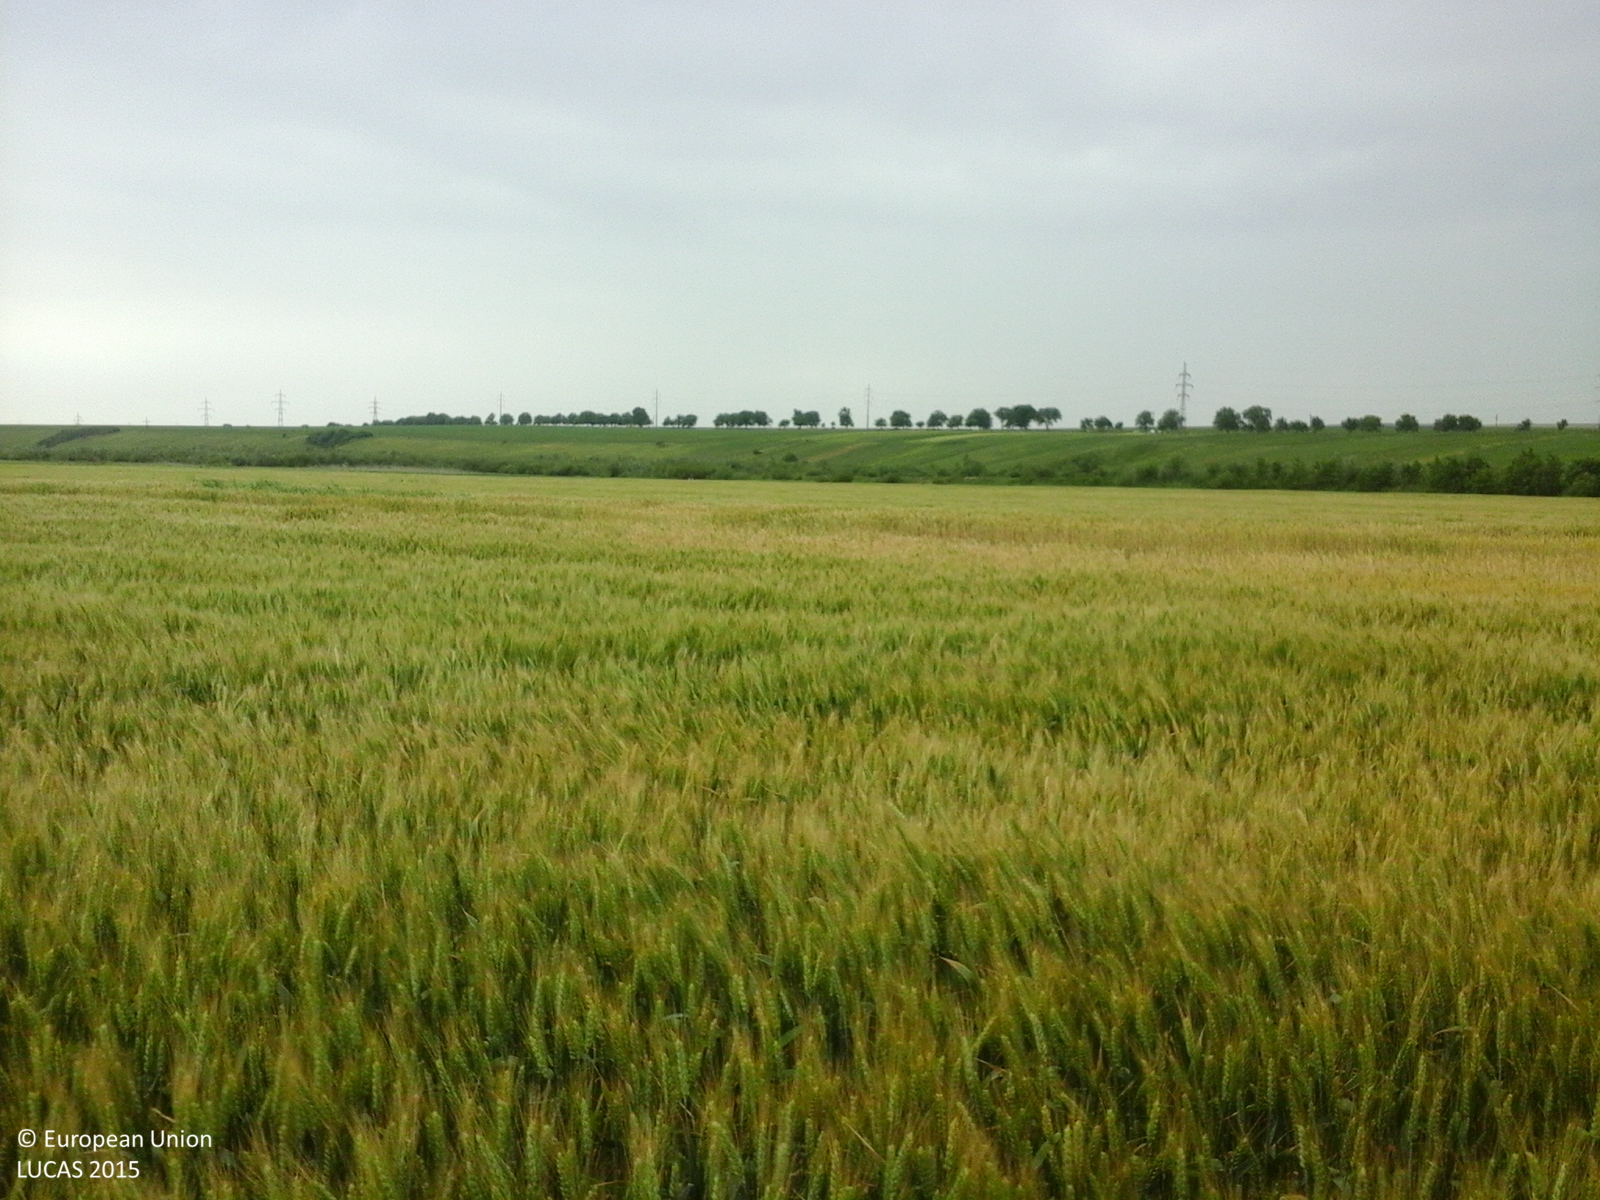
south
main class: Cropland
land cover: Common wheat
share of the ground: > 75 %
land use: Agriculture (excluding fallow land and kitchen gardens)
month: June
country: RO
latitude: 47.2887
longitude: 26.6868
